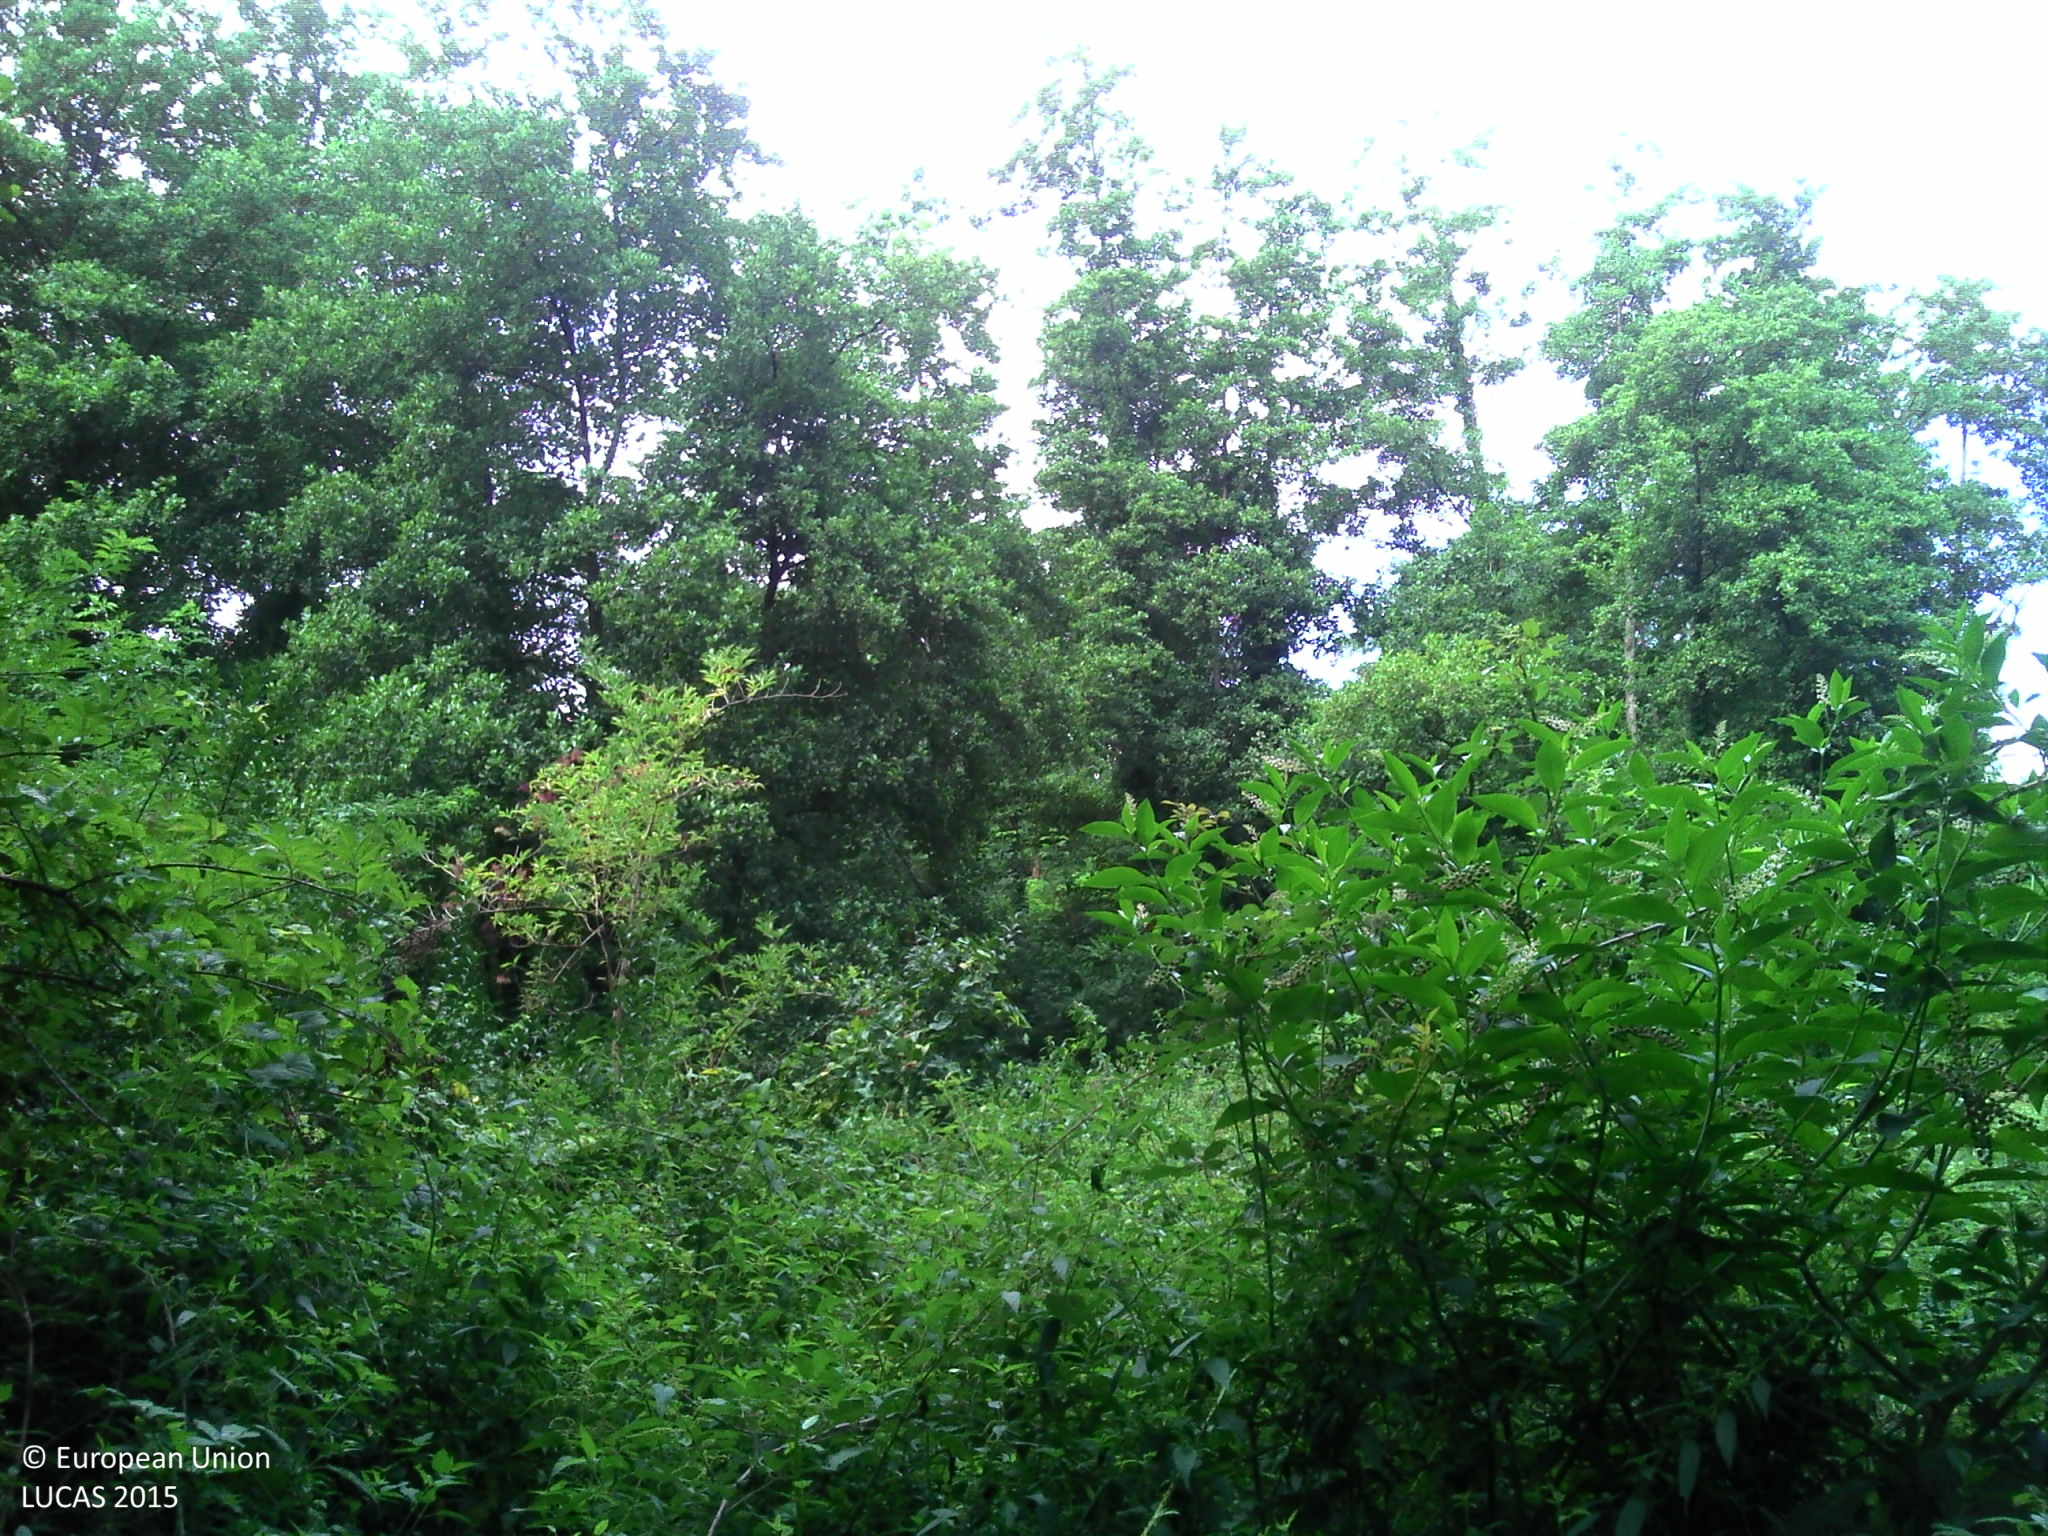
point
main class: Woodland
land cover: Broadleaved woodland
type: mesophytic deciduous forest
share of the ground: > 75 %
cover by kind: broadleaved forest trees 75 %, herbaceous plants 25 %
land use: Forestry
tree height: > 5 m
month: July
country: FR
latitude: 43.8400
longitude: -0.7975
